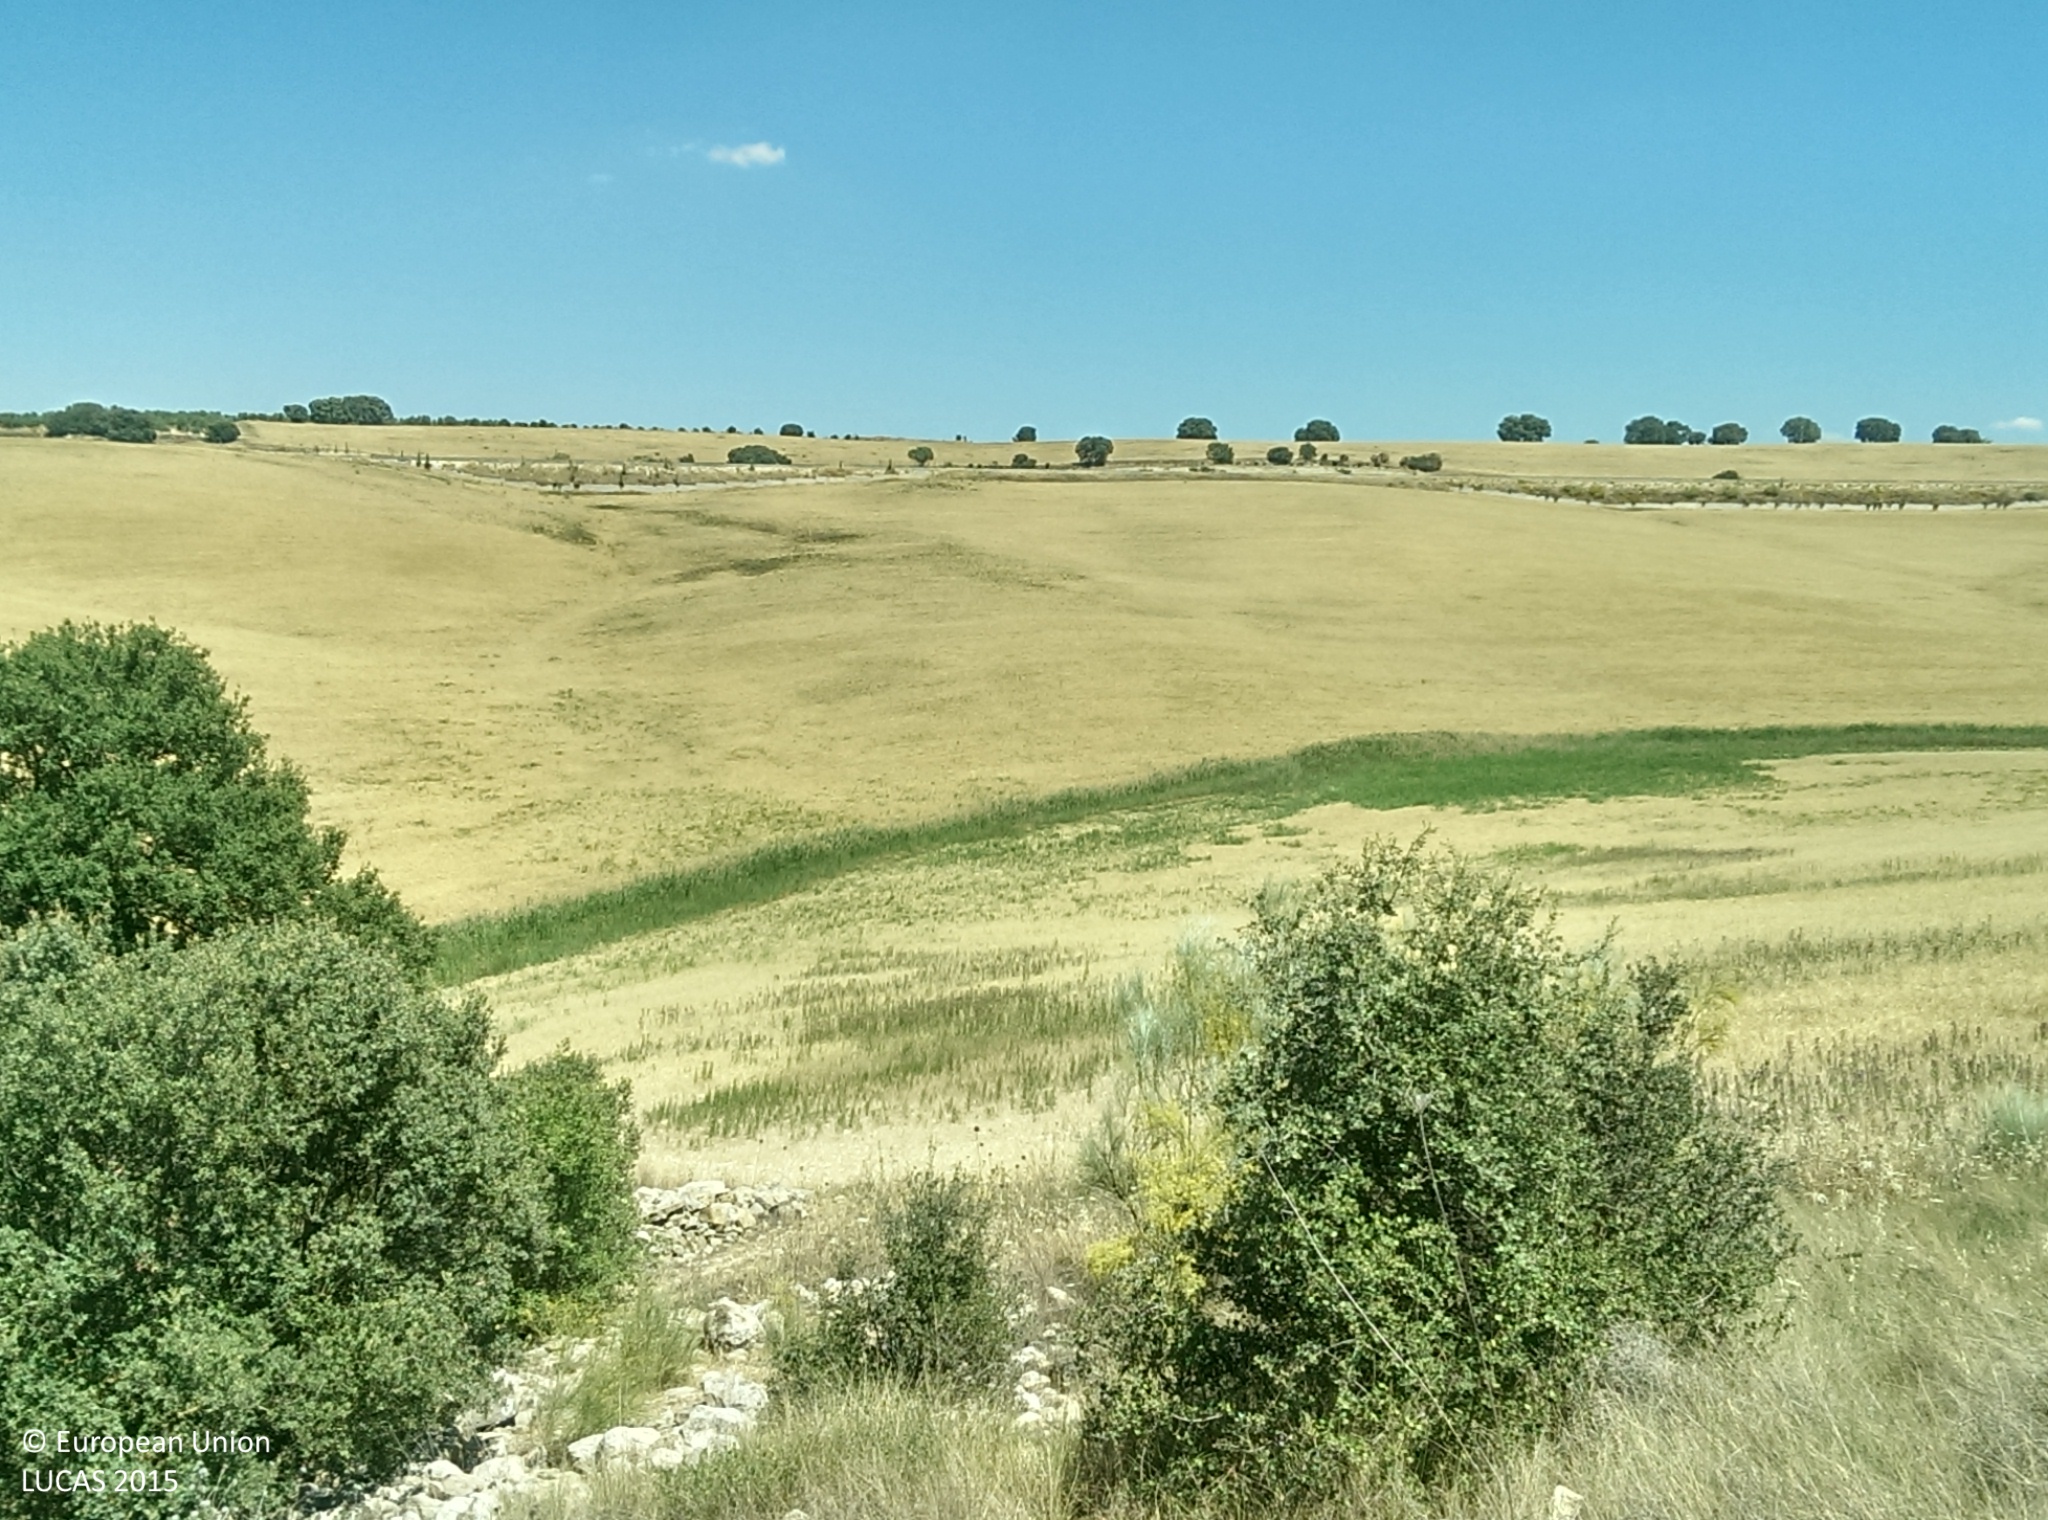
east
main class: Shrubland
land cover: Shrubland with sparse tree cover
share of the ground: 50 - 75 %
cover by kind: shrubs 50 %, herbaceous plants 40 %, broadleaved forest trees 5 %, unconsolidated bare surface 5 %
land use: Semi-natural and natural areas not in use
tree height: < 5 m
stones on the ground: 10 - 25 %
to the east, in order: Shrubland with sparse tree cover; Barley; Grass margins; Rivers and streams; Grass margins; Barley
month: June
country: ES
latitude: 37.5588
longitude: -3.3168
